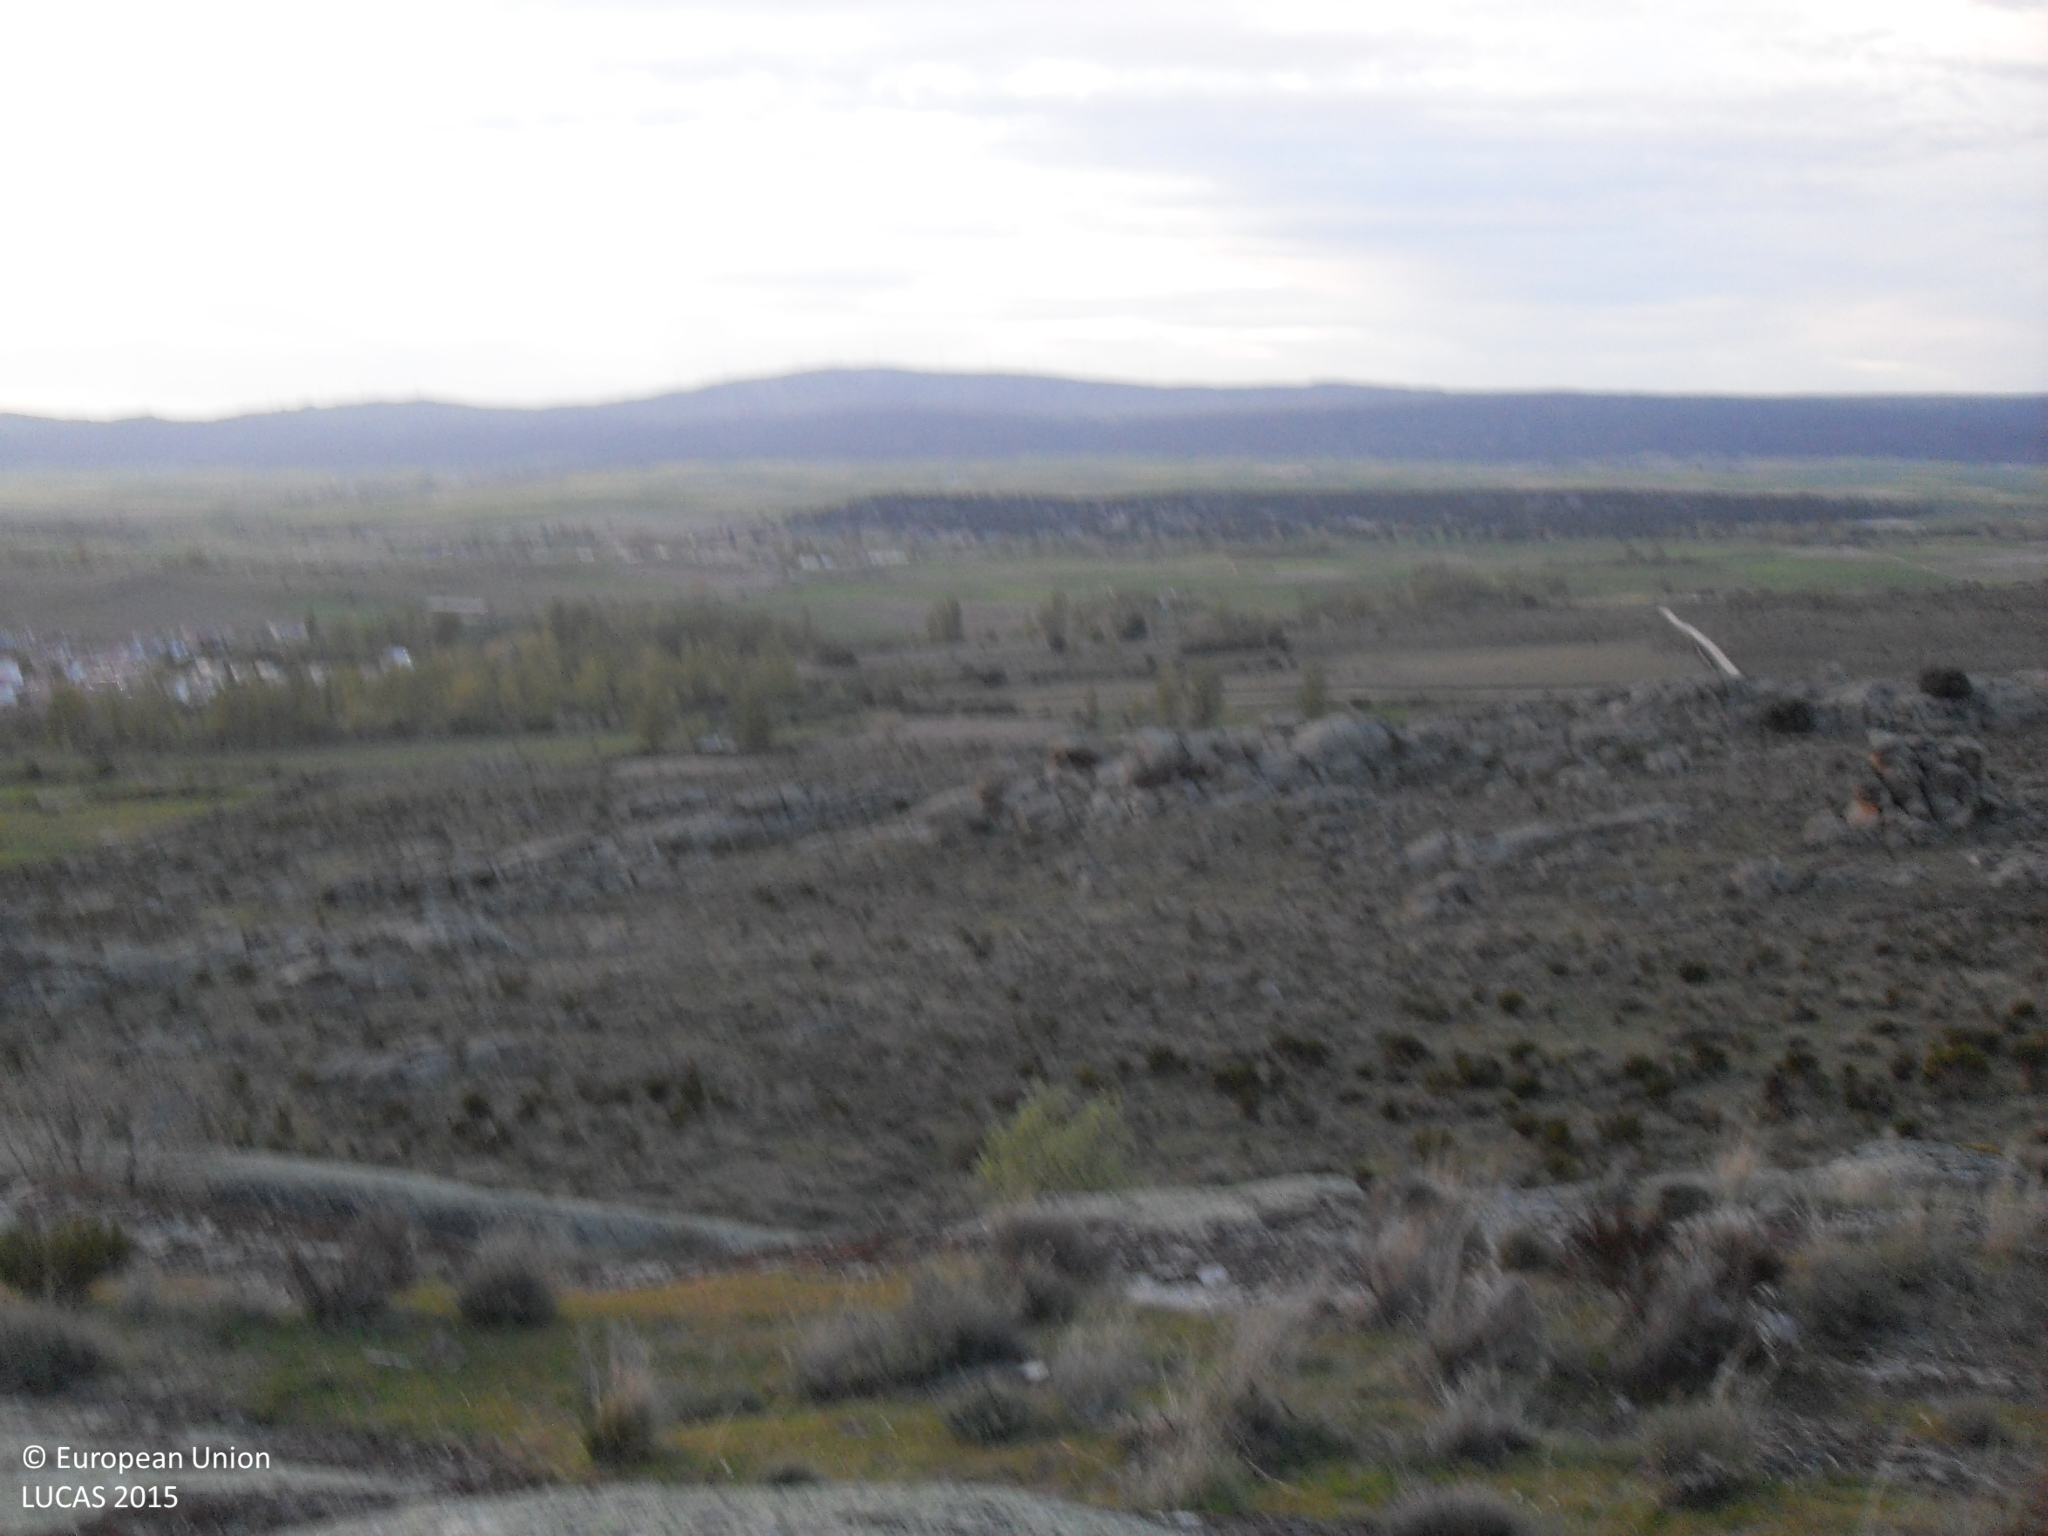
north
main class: Grassland
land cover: Grassland without tree/shrub cover
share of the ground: > 75 %
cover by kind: consolidated bare surface 80 %, herbaceous plants 20 %
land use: Agriculture (excluding fallow land and kitchen gardens)
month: May
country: ES
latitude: 40.5328
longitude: -4.9207
